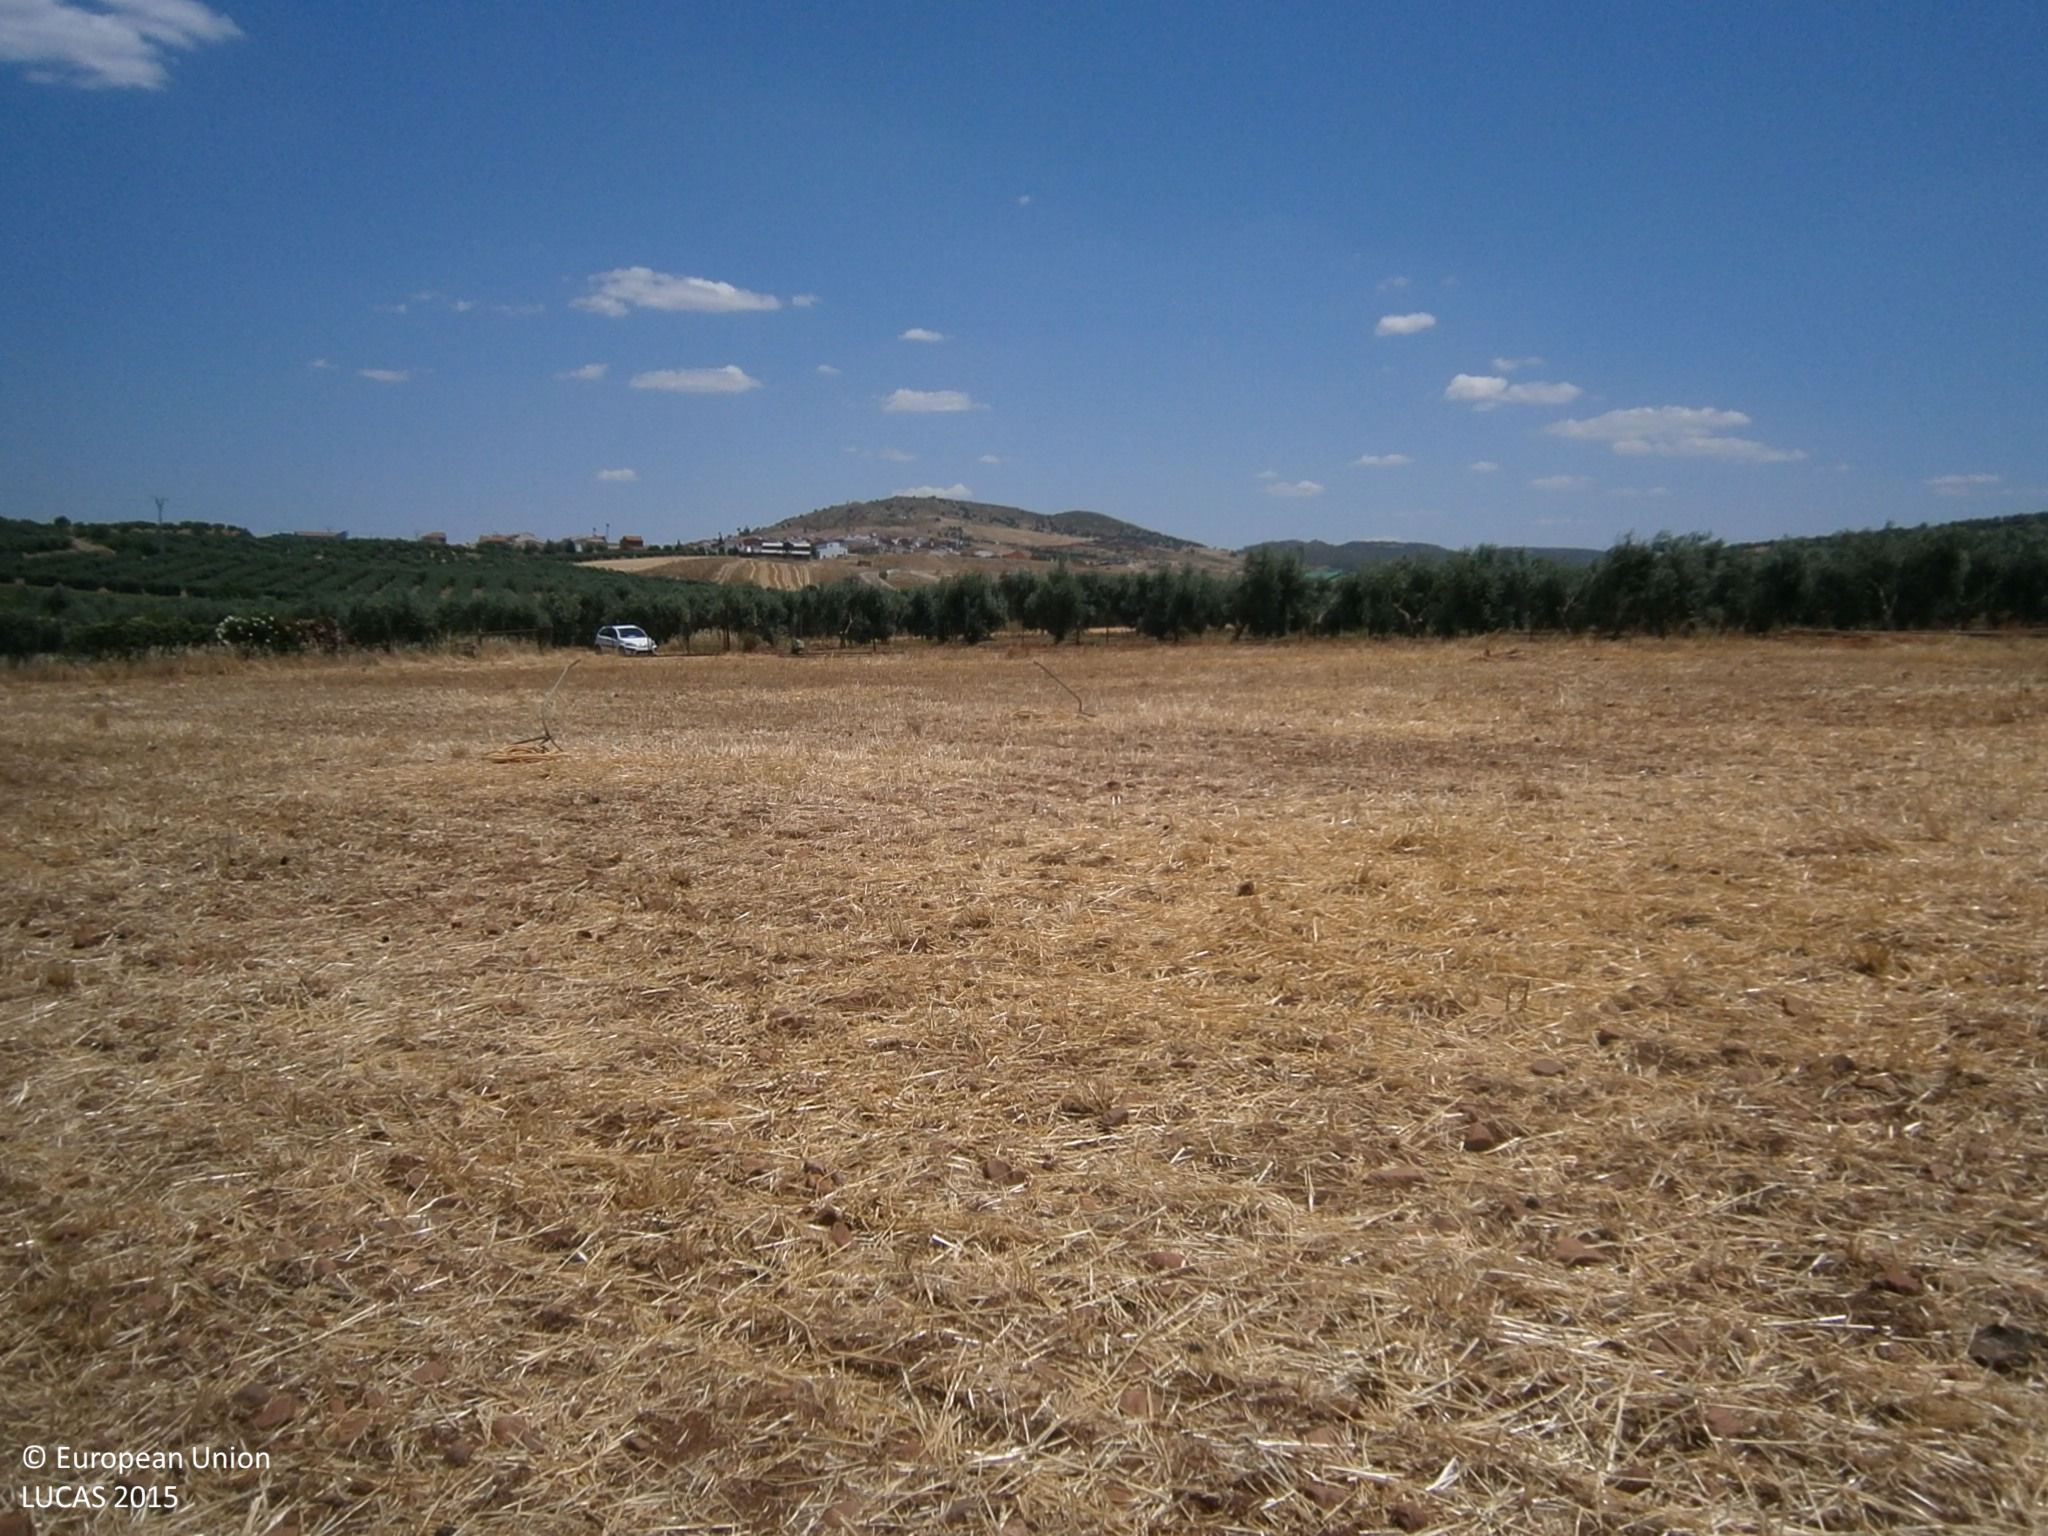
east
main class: Cropland
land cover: Temporary grasslands
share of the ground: > 75 %
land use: Agriculture (excluding fallow land and kitchen gardens)
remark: Harvested field
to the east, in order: Temporary grasslands; Tracks; Fences; Olive groves; Fences; Tracks; Olive groves
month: June
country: ES
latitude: 38.8129
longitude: -6.2343
